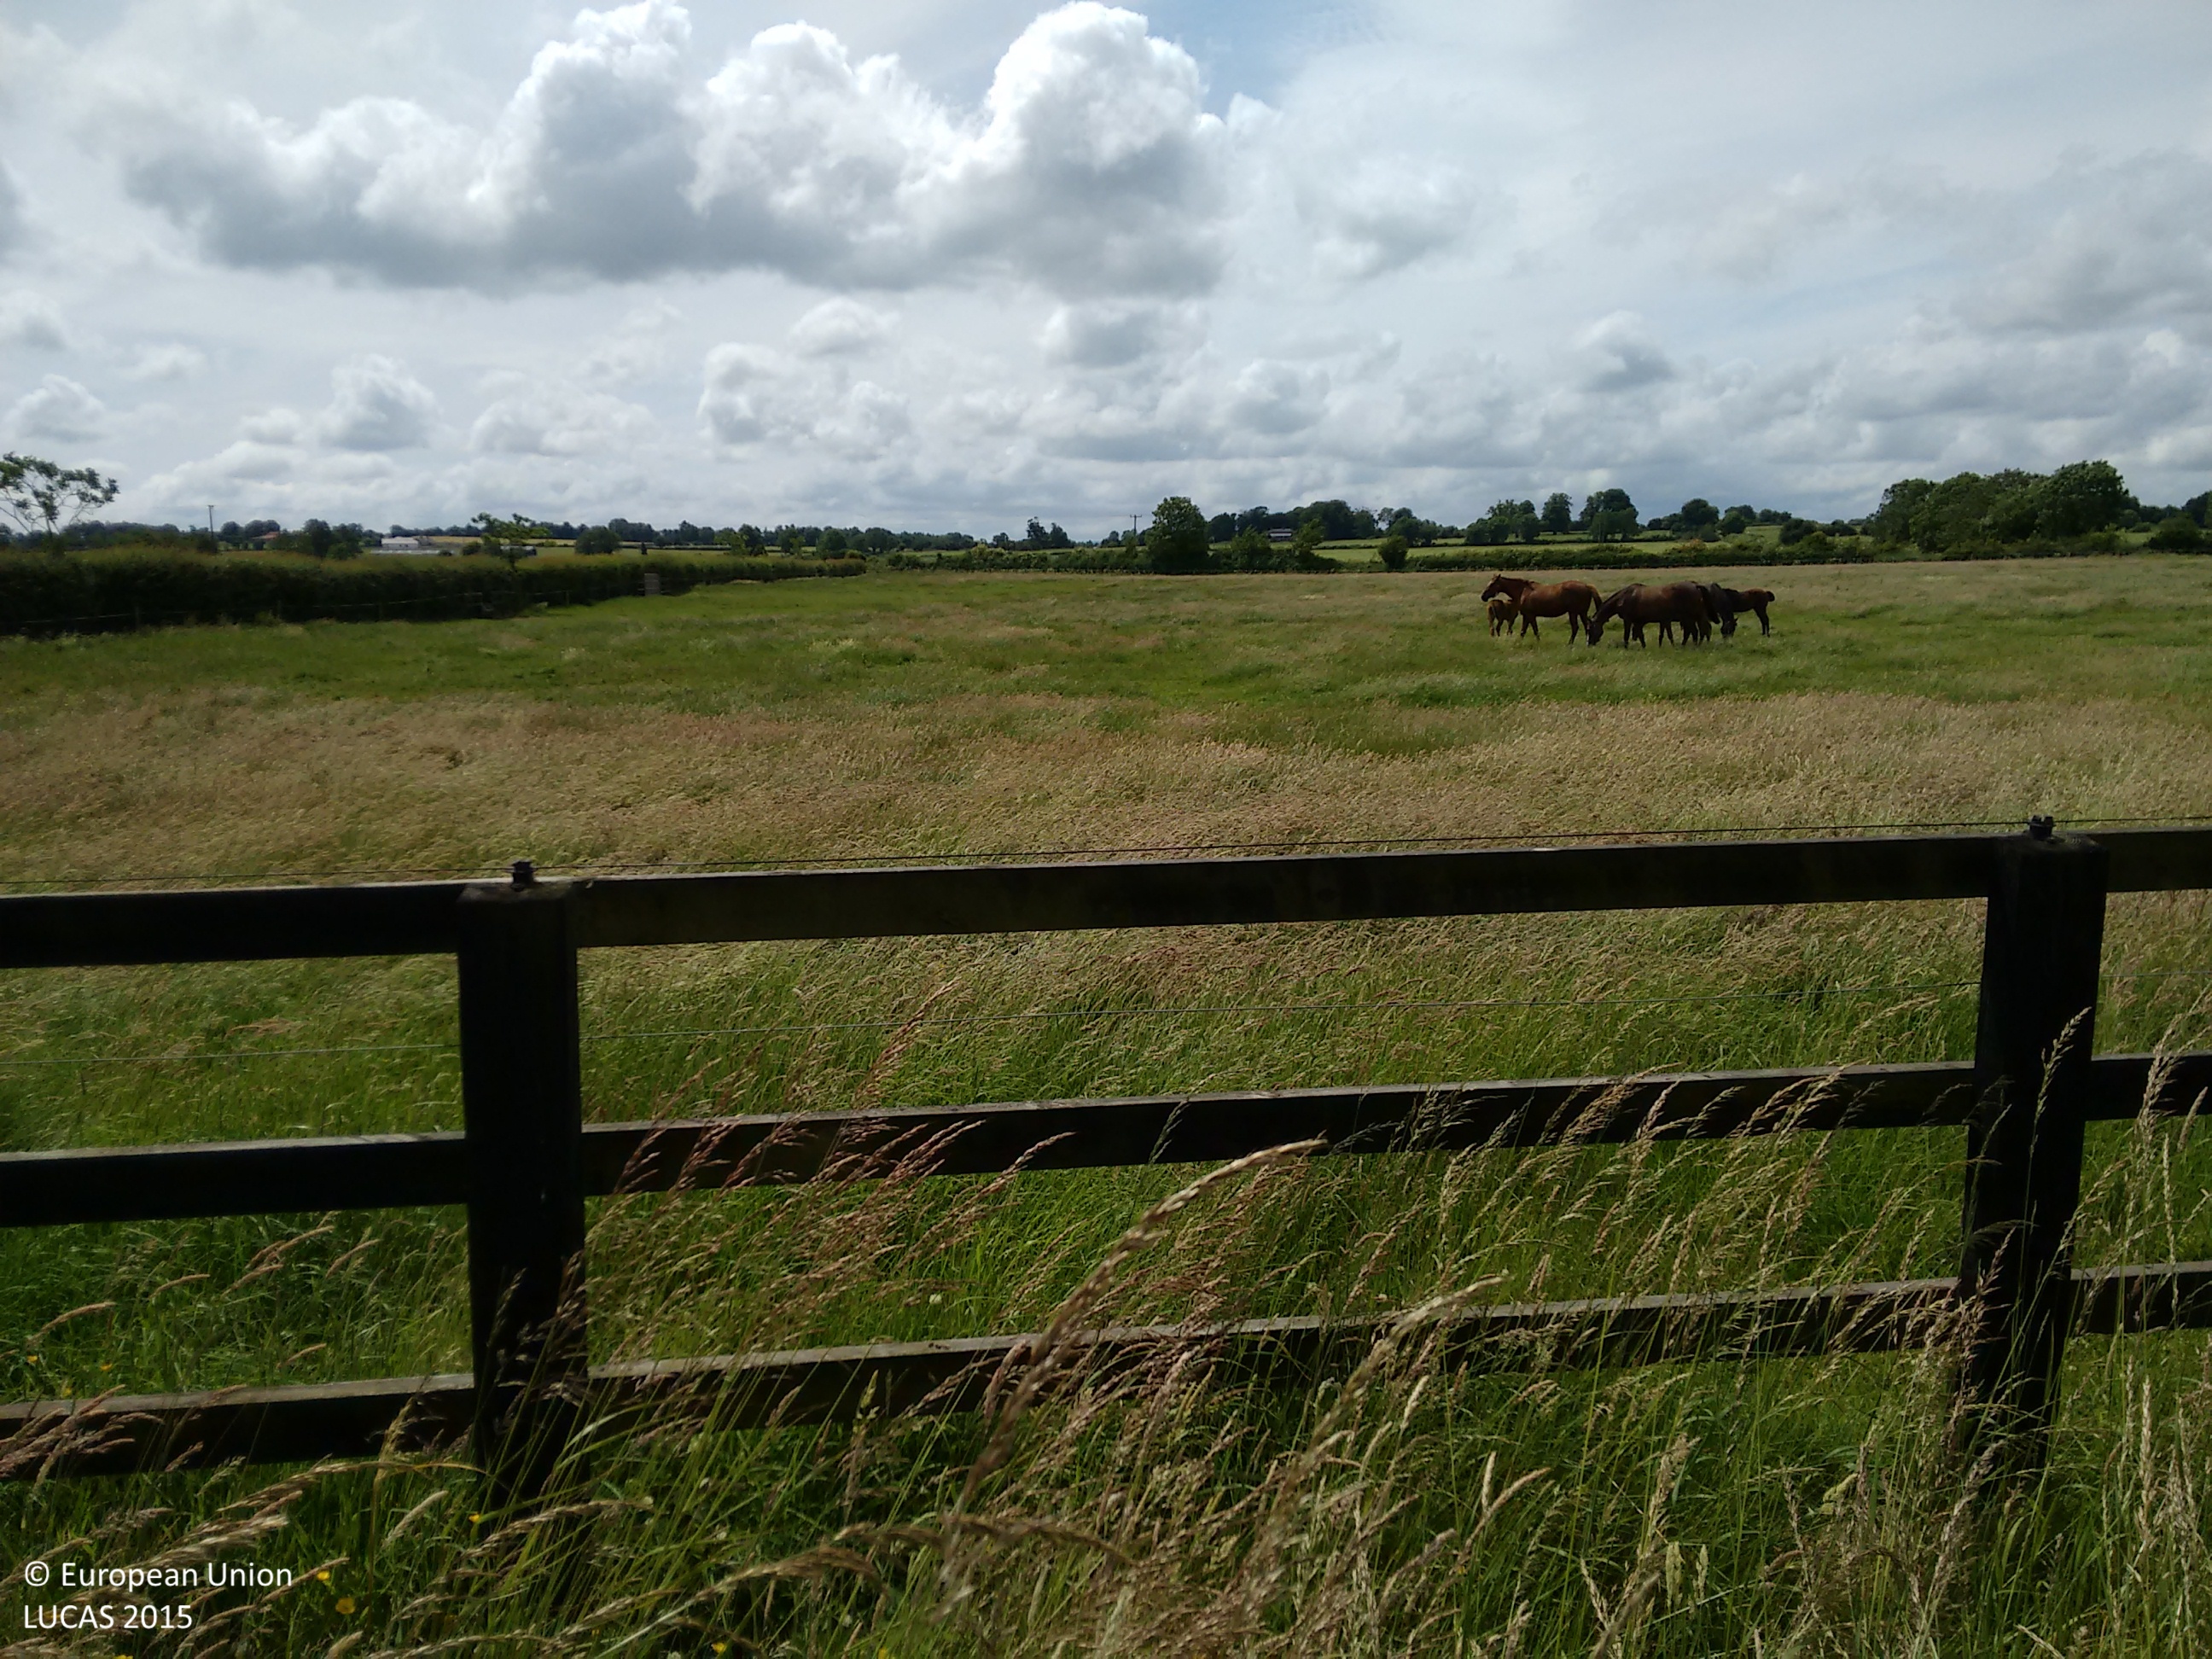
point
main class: Grassland
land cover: Grassland without tree/shrub cover
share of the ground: > 75 %
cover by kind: herbaceous plants 100 %
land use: Agriculture (excluding fallow land and kitchen gardens)
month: July
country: IE
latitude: 52.4828
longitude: -7.7338
